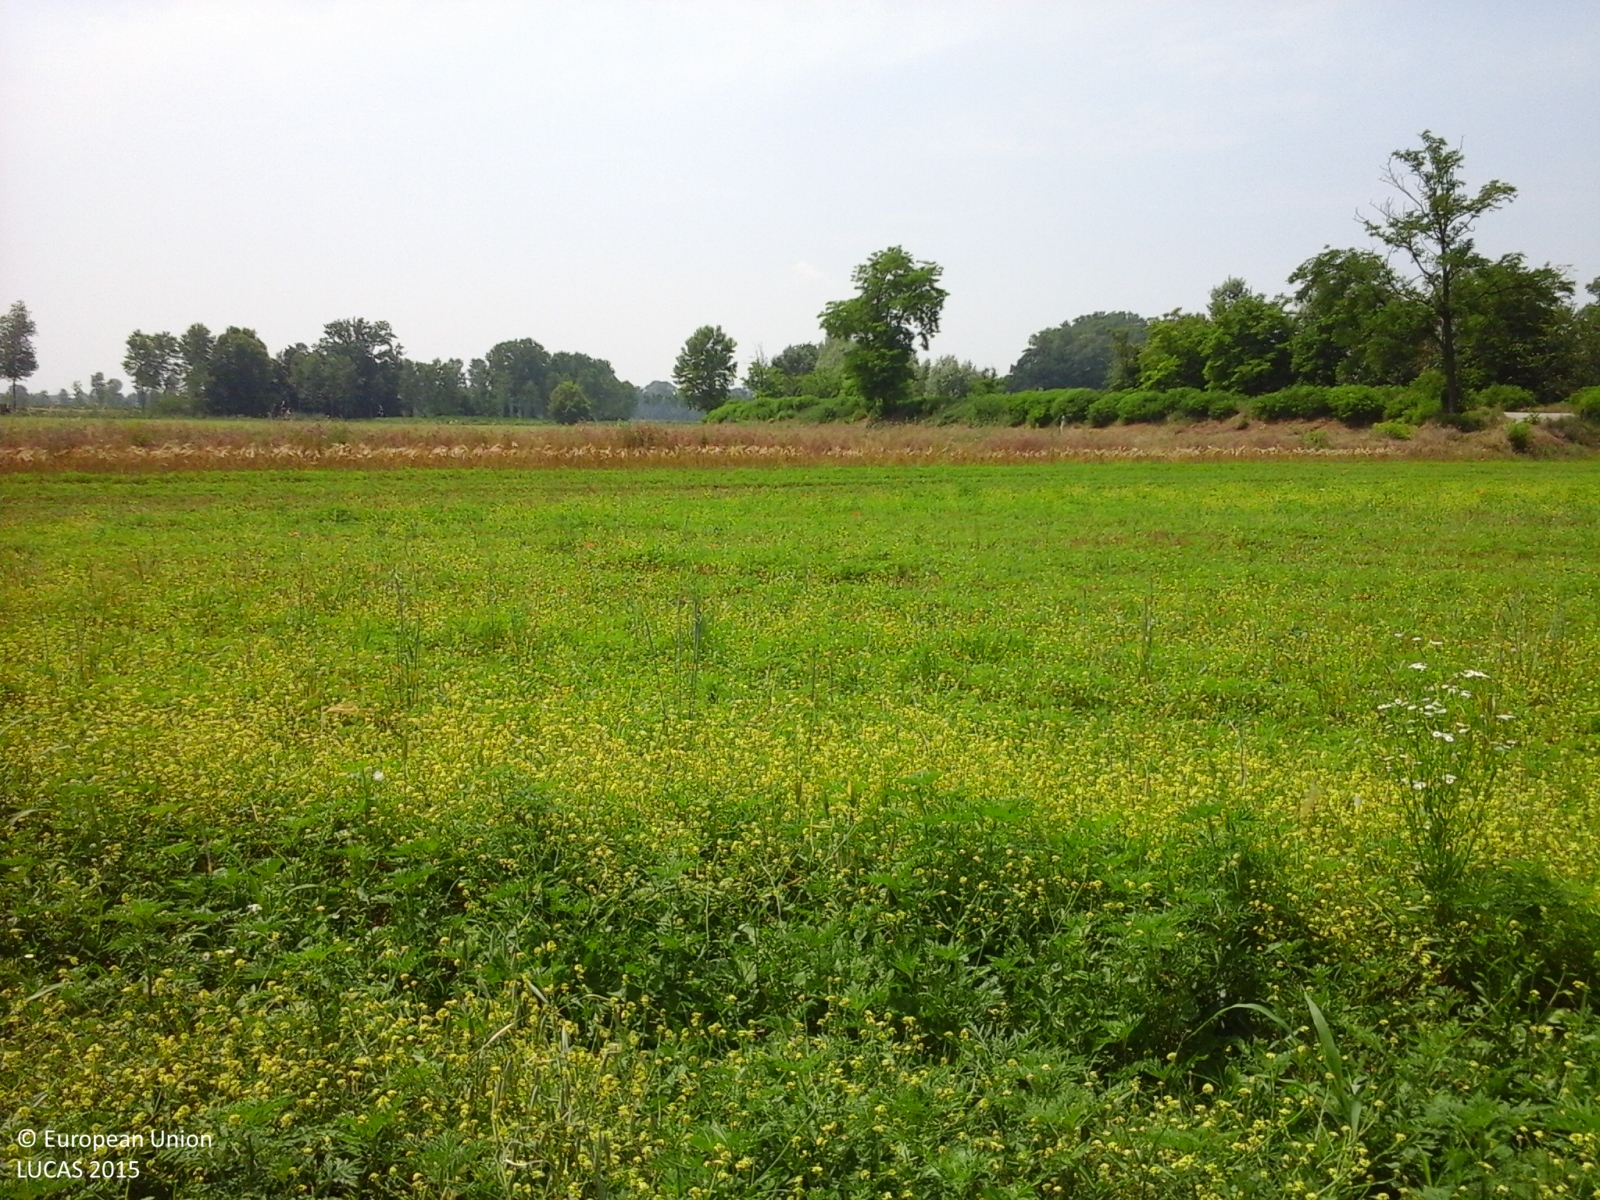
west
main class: Grassland
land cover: Spontaneously vegetated surfaces
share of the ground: > 75 %
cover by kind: herbaceous plants 100 %
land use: Agriculture (excluding fallow land and kitchen gardens)
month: June
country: IT
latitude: 45.2695
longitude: 9.6565
